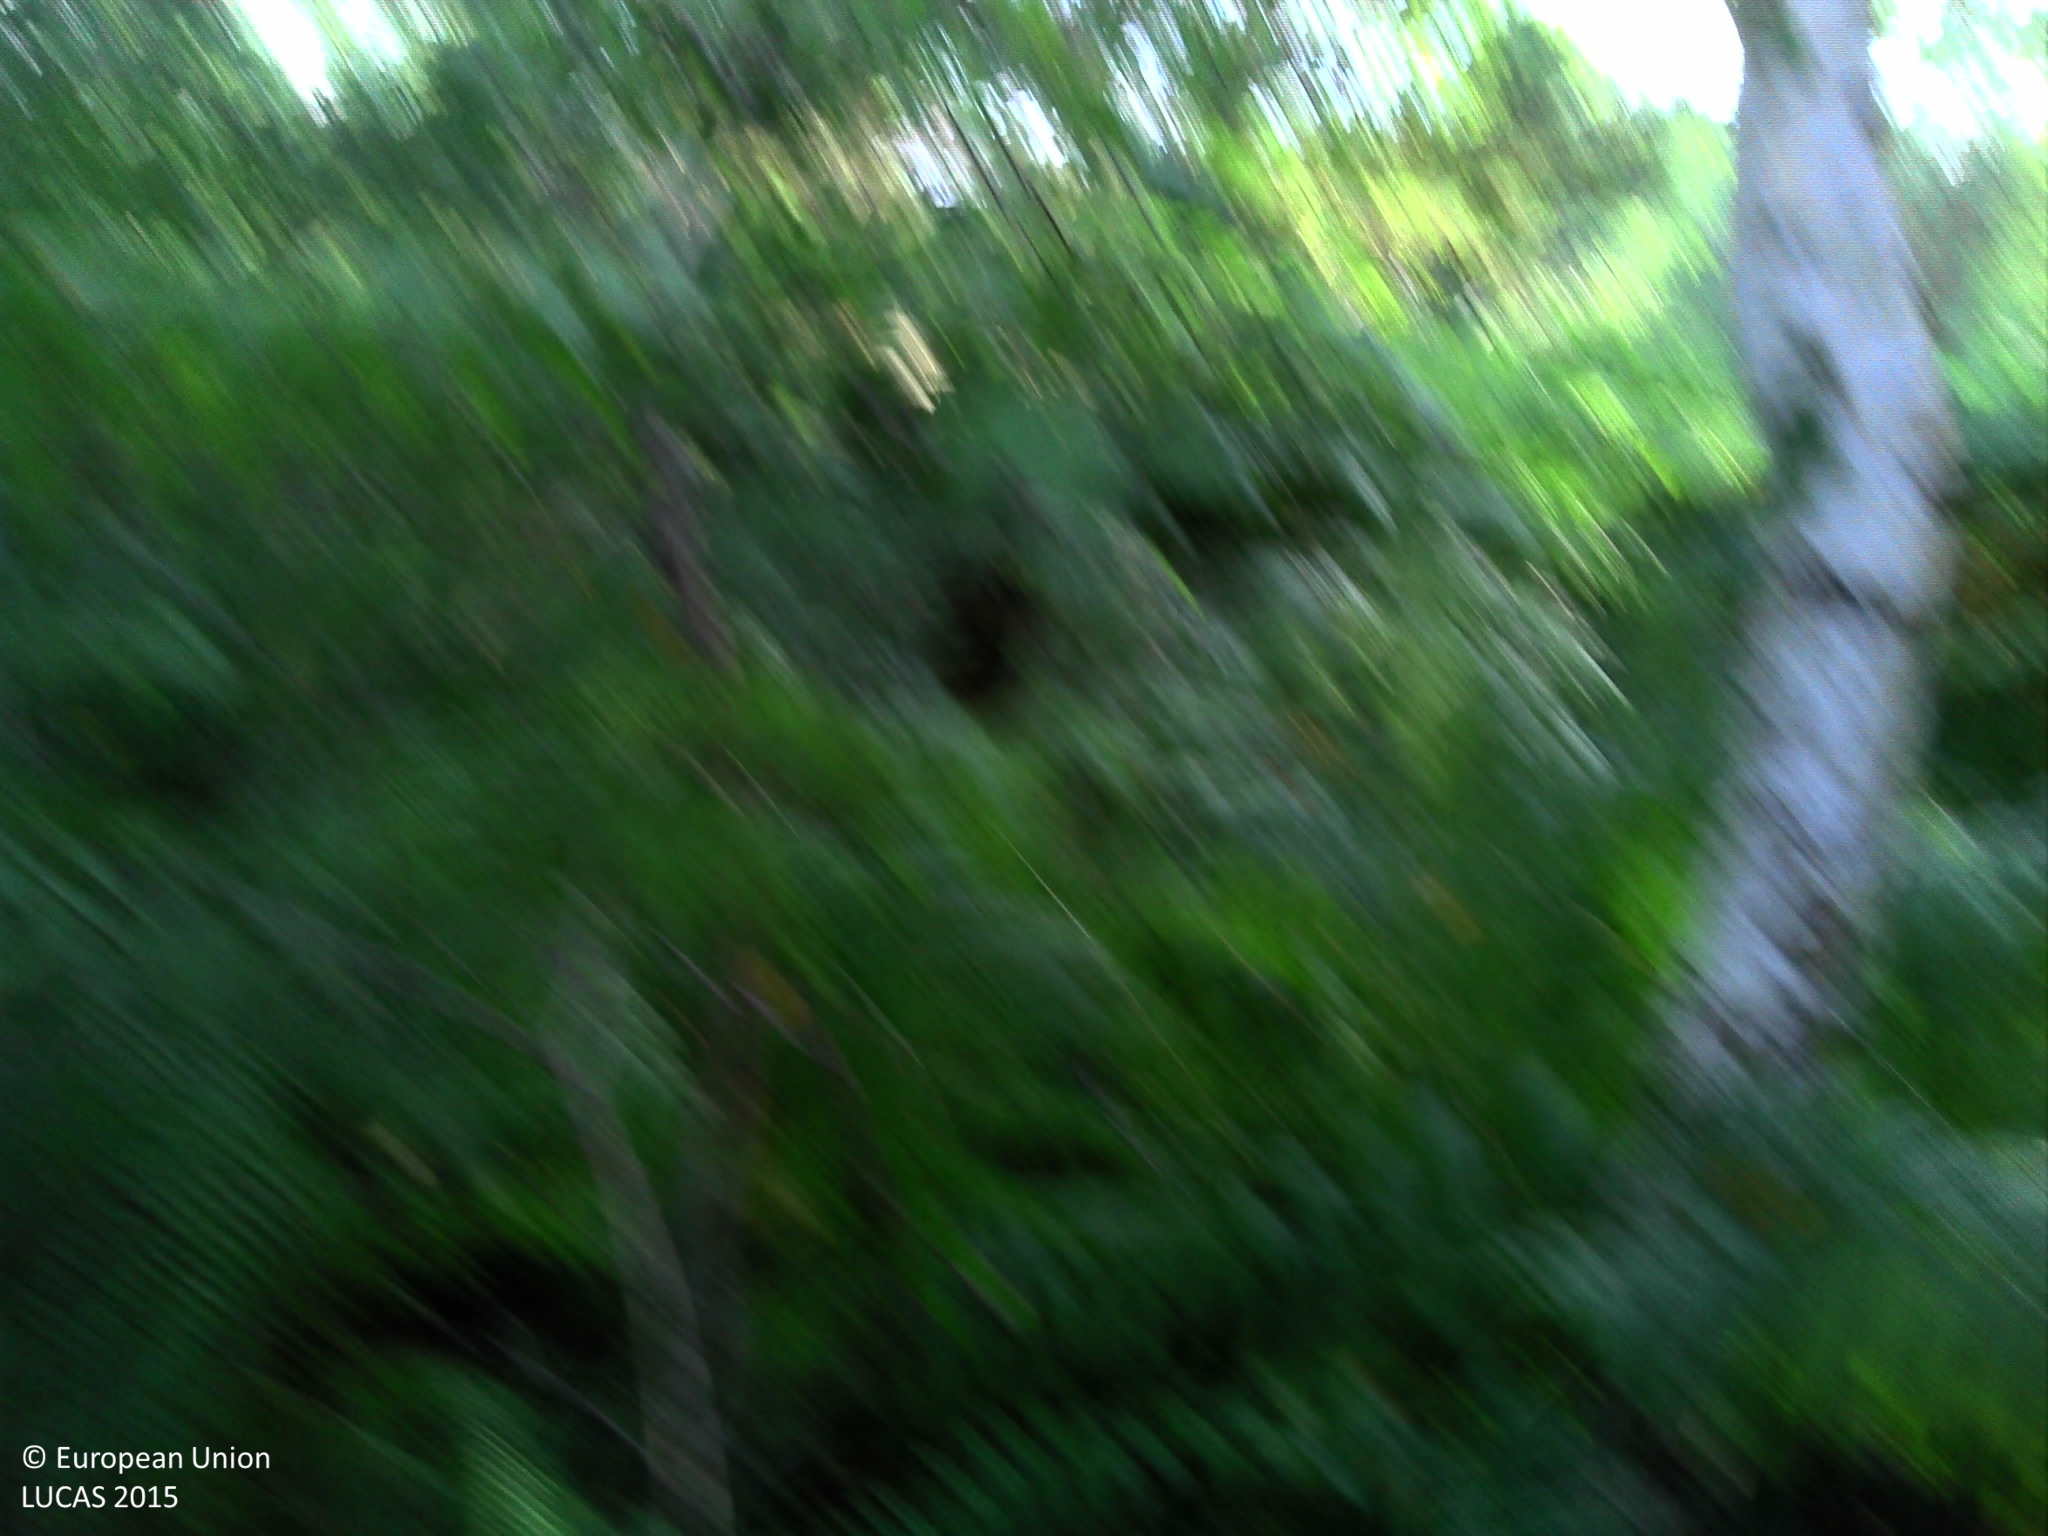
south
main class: Woodland
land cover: Pine dominated mixed woodland
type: acidophilous oak and oak-birch forest
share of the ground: > 75 %
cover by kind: herbaceous plants 60 %, broadleaved forest trees 30 %, coniferous forest trees 10 %
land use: Forestry
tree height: > 5 m
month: August
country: FR
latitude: 47.2924
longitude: 2.1493
